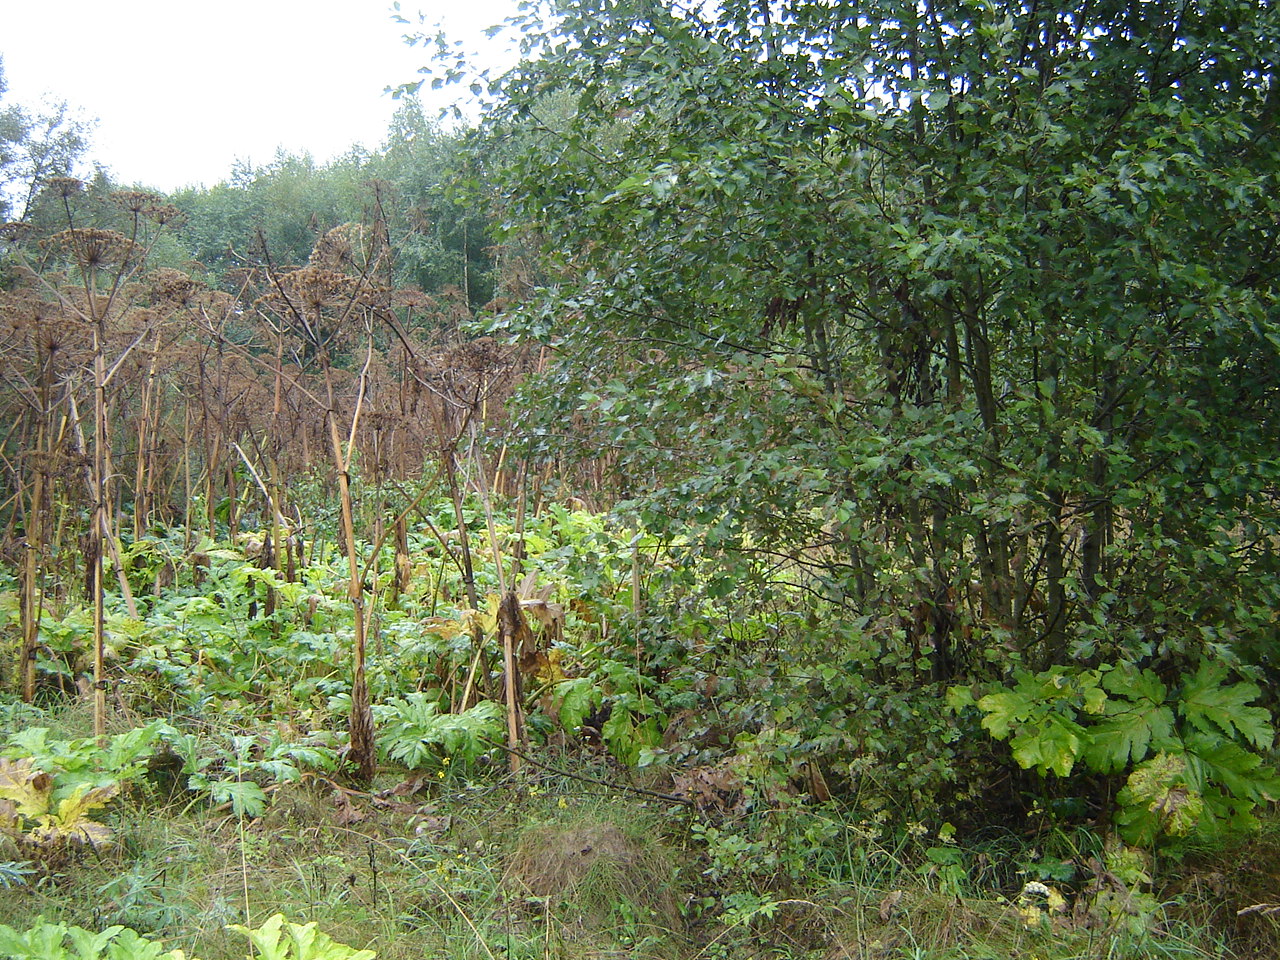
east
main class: Woodland
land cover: Pine dominated mixed woodland
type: hemiboreal forest and nemoral coniferous forest and mixed broadleaved-coniferous forest
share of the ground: > 75 %
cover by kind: broadleaved forest trees 55 %, coniferous forest trees 30 %, herbaceous plants 15 %
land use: Forestry
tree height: > 5 m
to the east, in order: Pine dominated mixed woodland; Broadleaved woodland; Spontaneously vegetated surfaces; Single bushes/trees; Grass margins; Potatoes; Grassland without tree/shrub cover
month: September
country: LT
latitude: 54.9976
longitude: 25.3638
